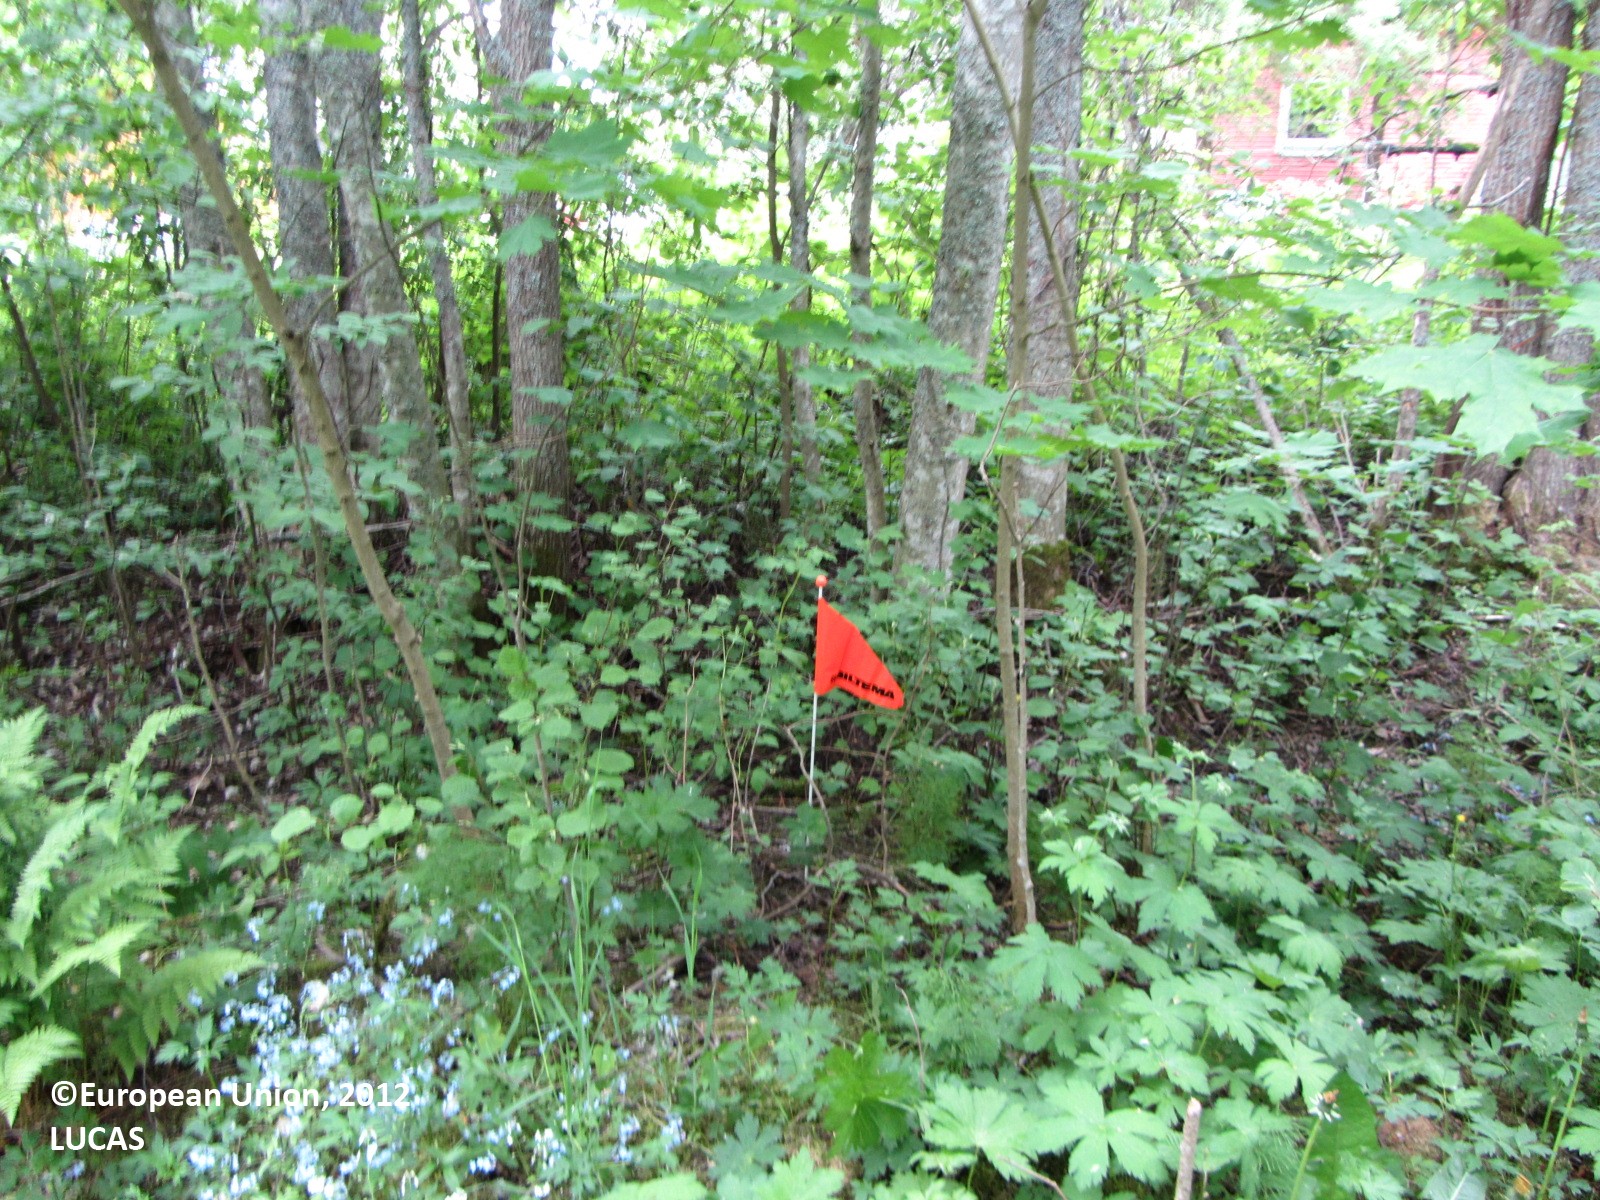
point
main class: Woodland
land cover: Broadleaved woodland
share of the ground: 50 - 75 %
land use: Semi-natural and natural areas not in use
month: June
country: FI
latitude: 61.8583
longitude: 25.1429
